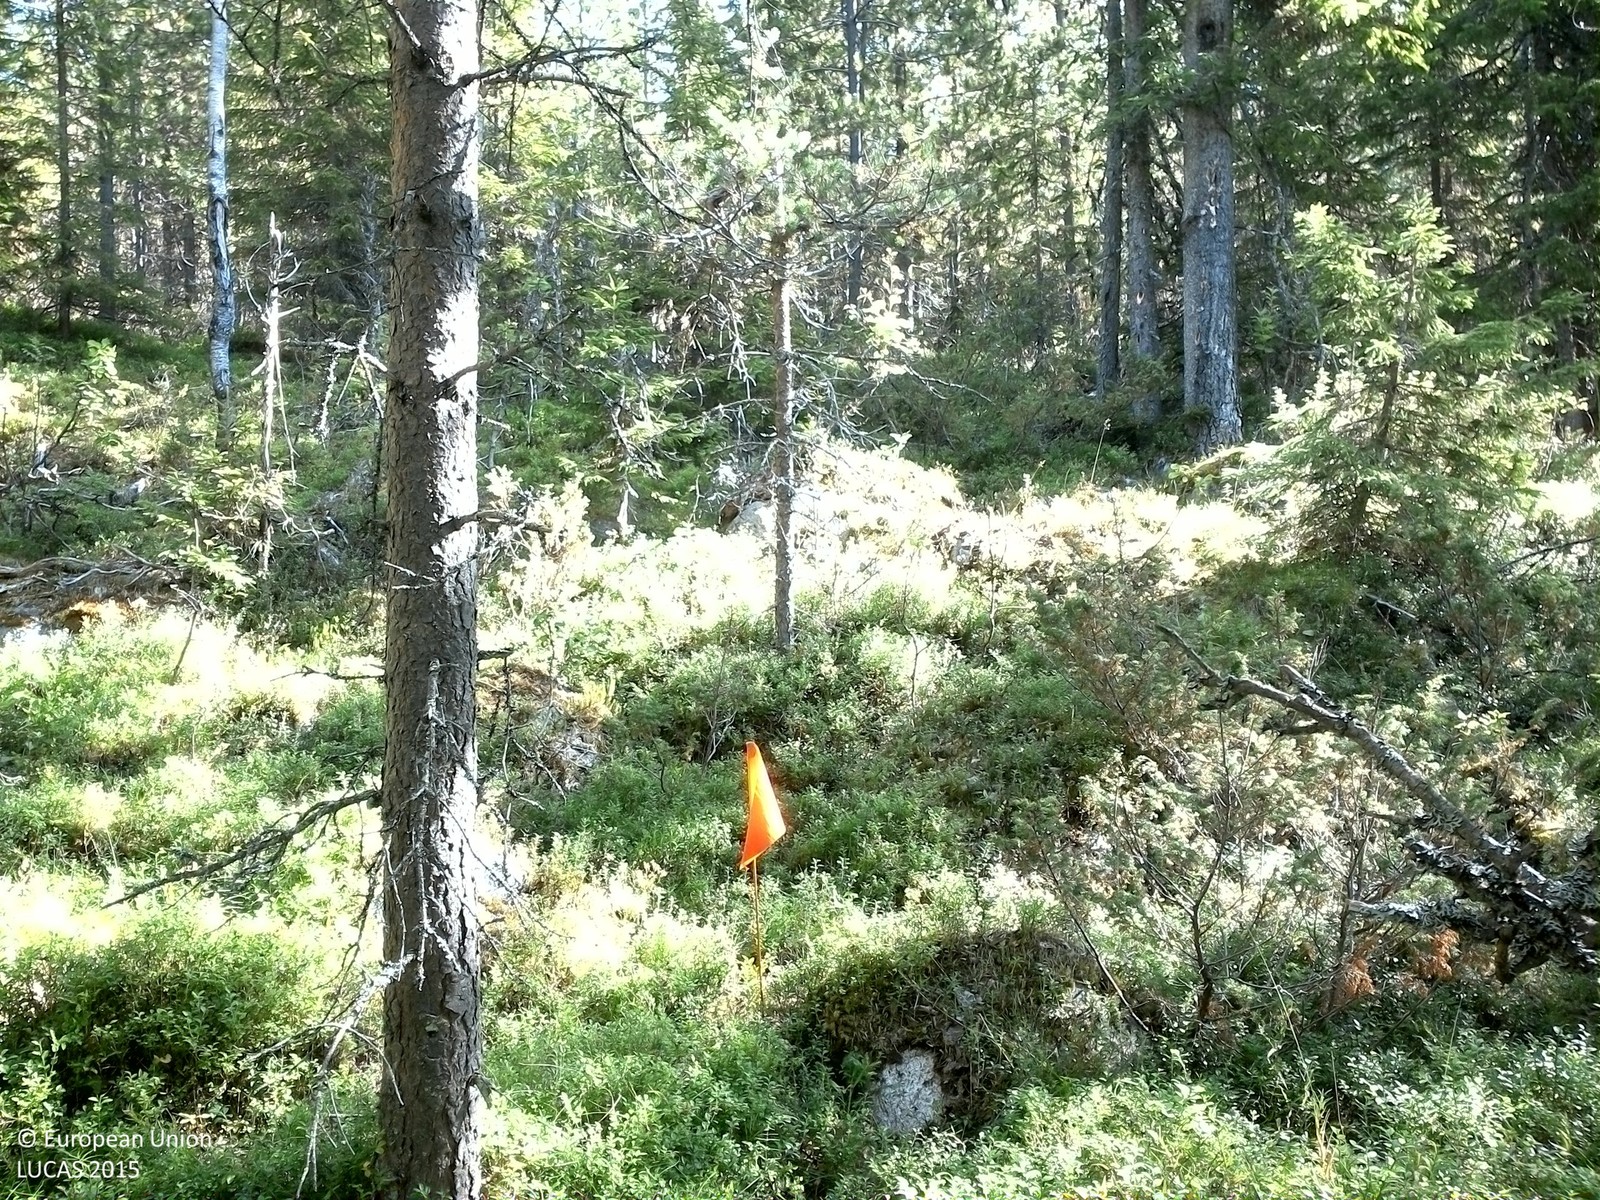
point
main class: Woodland
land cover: Pine dominated mixed woodland
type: boreal forest
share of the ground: 50 - 75 %
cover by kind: coniferous forest trees 35 %, shrubs 35 %, broadleaved forest trees 30 %
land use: Forestry
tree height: > 5 m
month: August
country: SE
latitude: 63.9068
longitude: 17.6131
